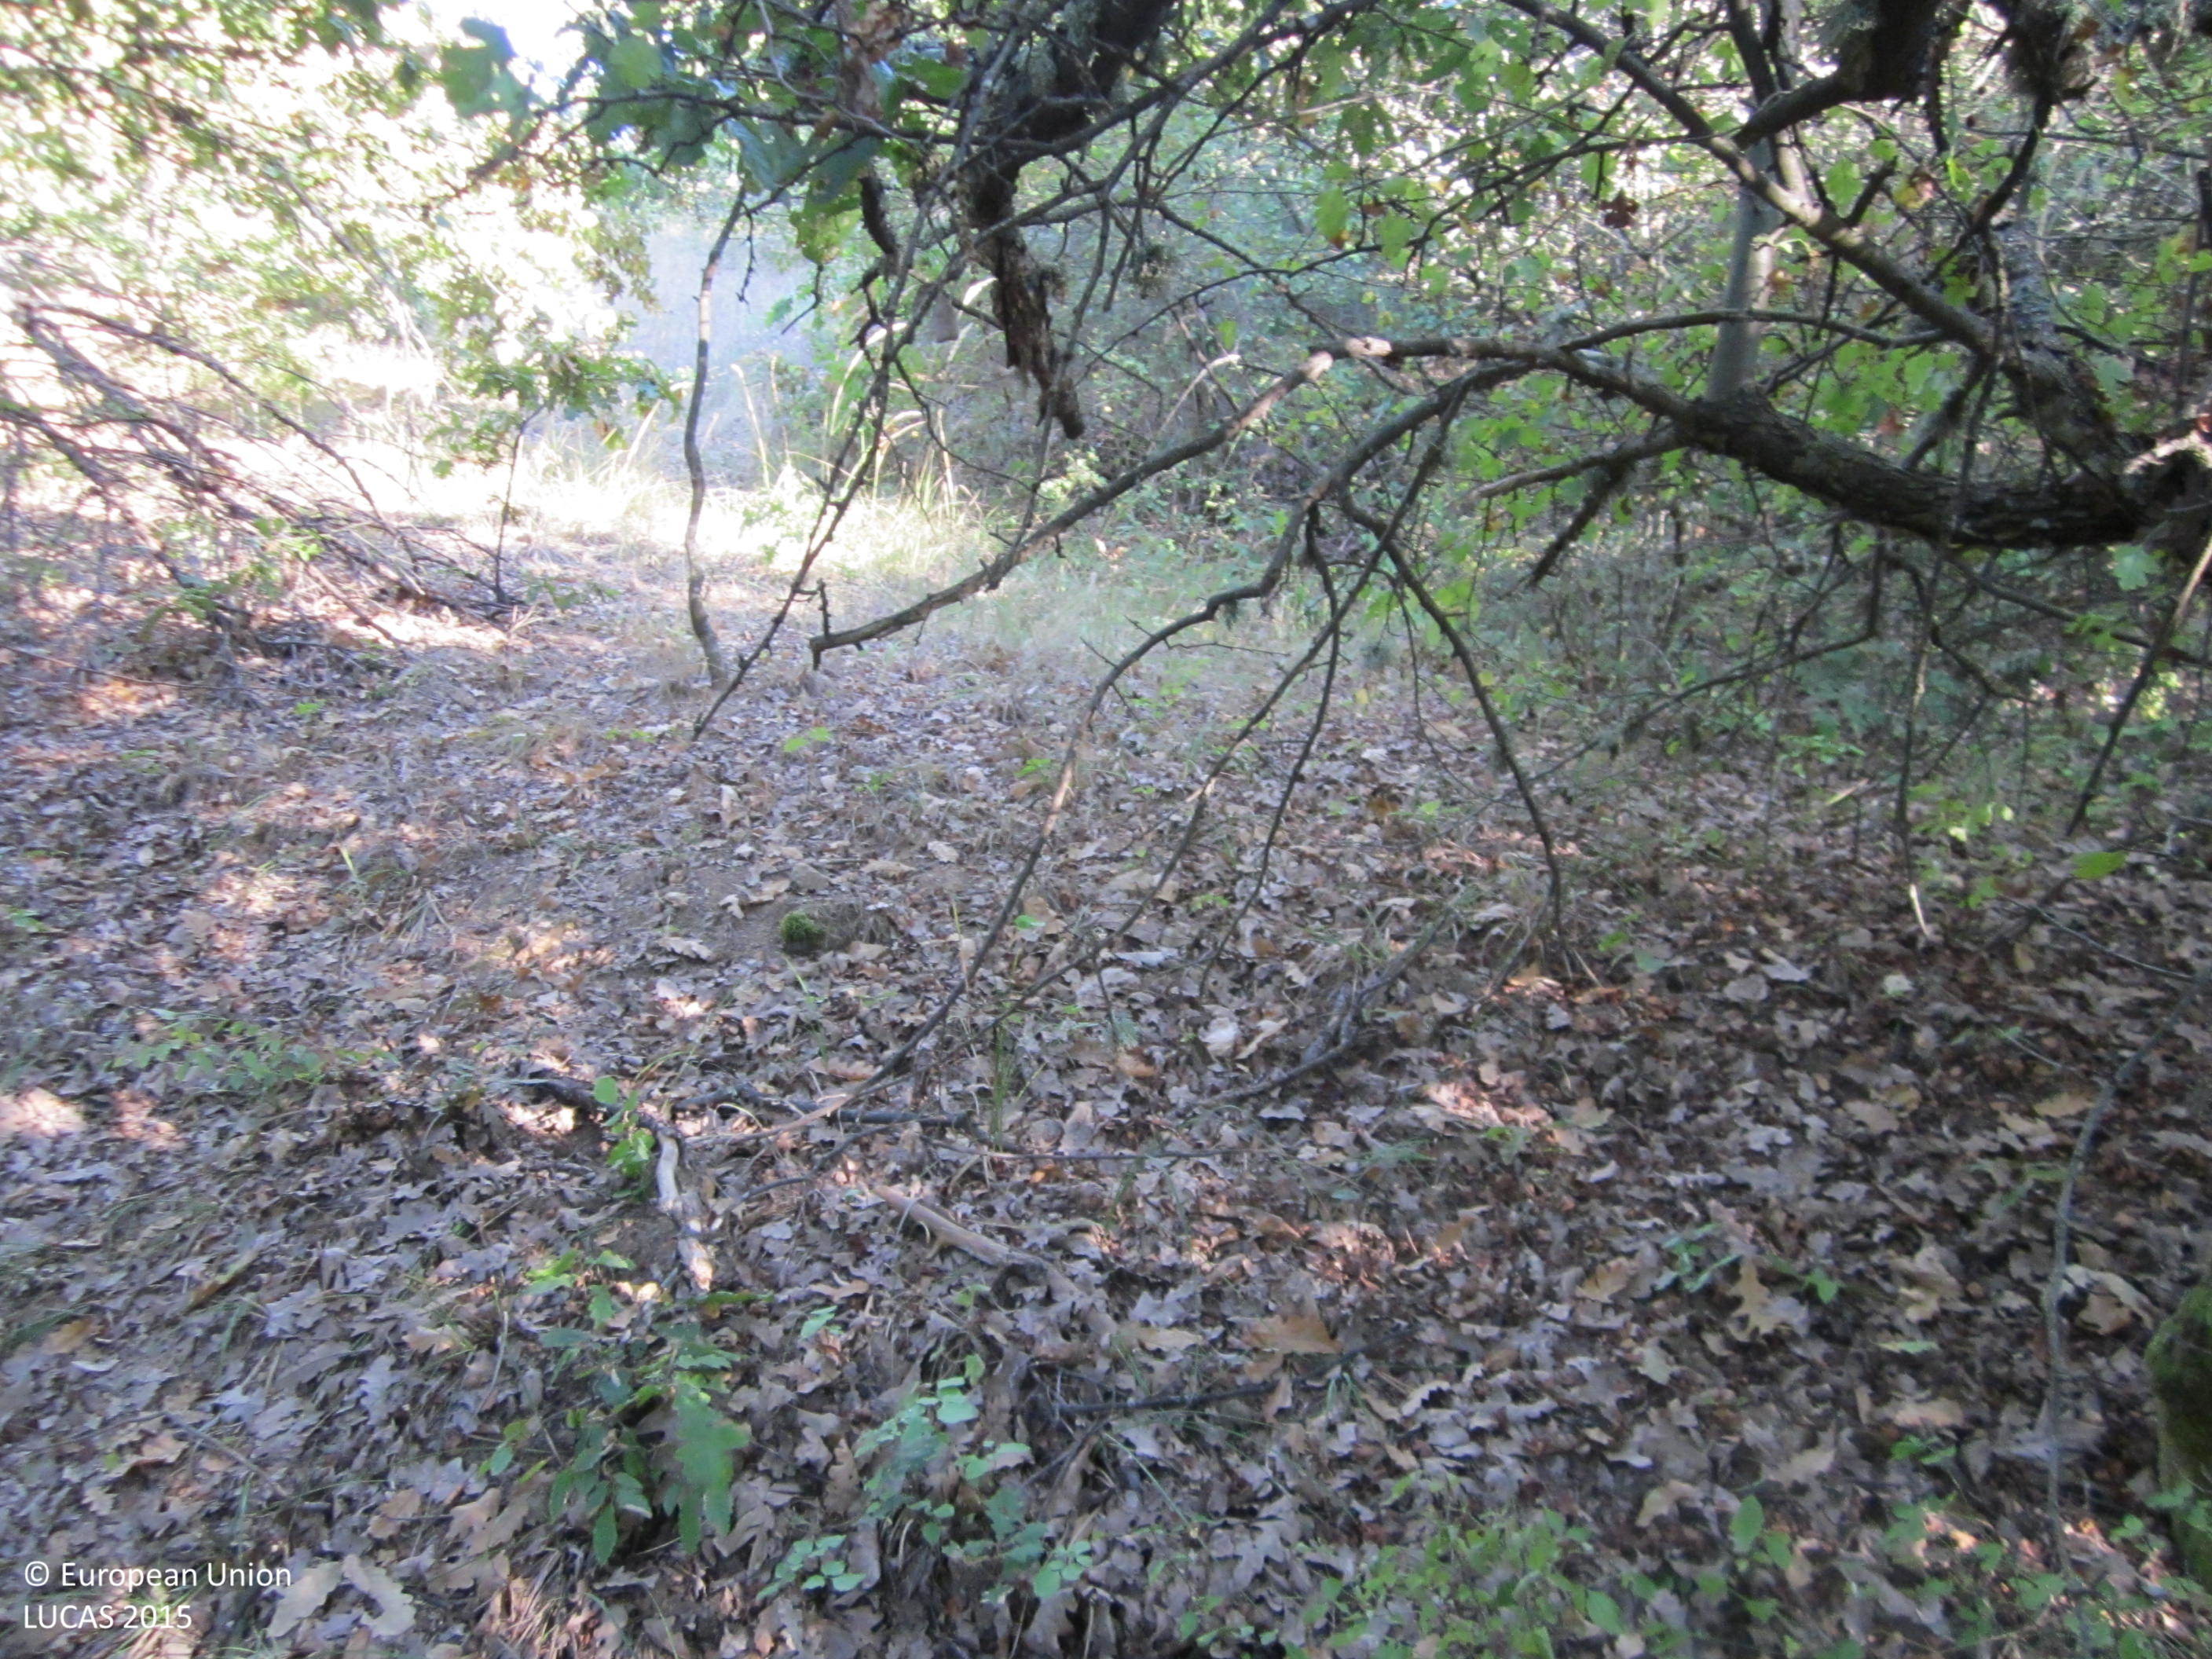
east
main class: Woodland
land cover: Broadleaved woodland
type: thermophilous deciduous forest
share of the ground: 50 - 75 %
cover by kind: broadleaved forest trees 70 %, unconsolidated bare surface 20 %, shrubs 5 %, herbaceous plants 5 %
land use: Forestry
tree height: > 5 m
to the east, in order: Broadleaved woodland; Shrubland with sparse tree cover; Grassland with sparse tree/shrub cover; Broadleaved woodland; Ditches and canals; Broadleaved woodland
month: September
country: BG
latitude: 42.1052
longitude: 27.1167
